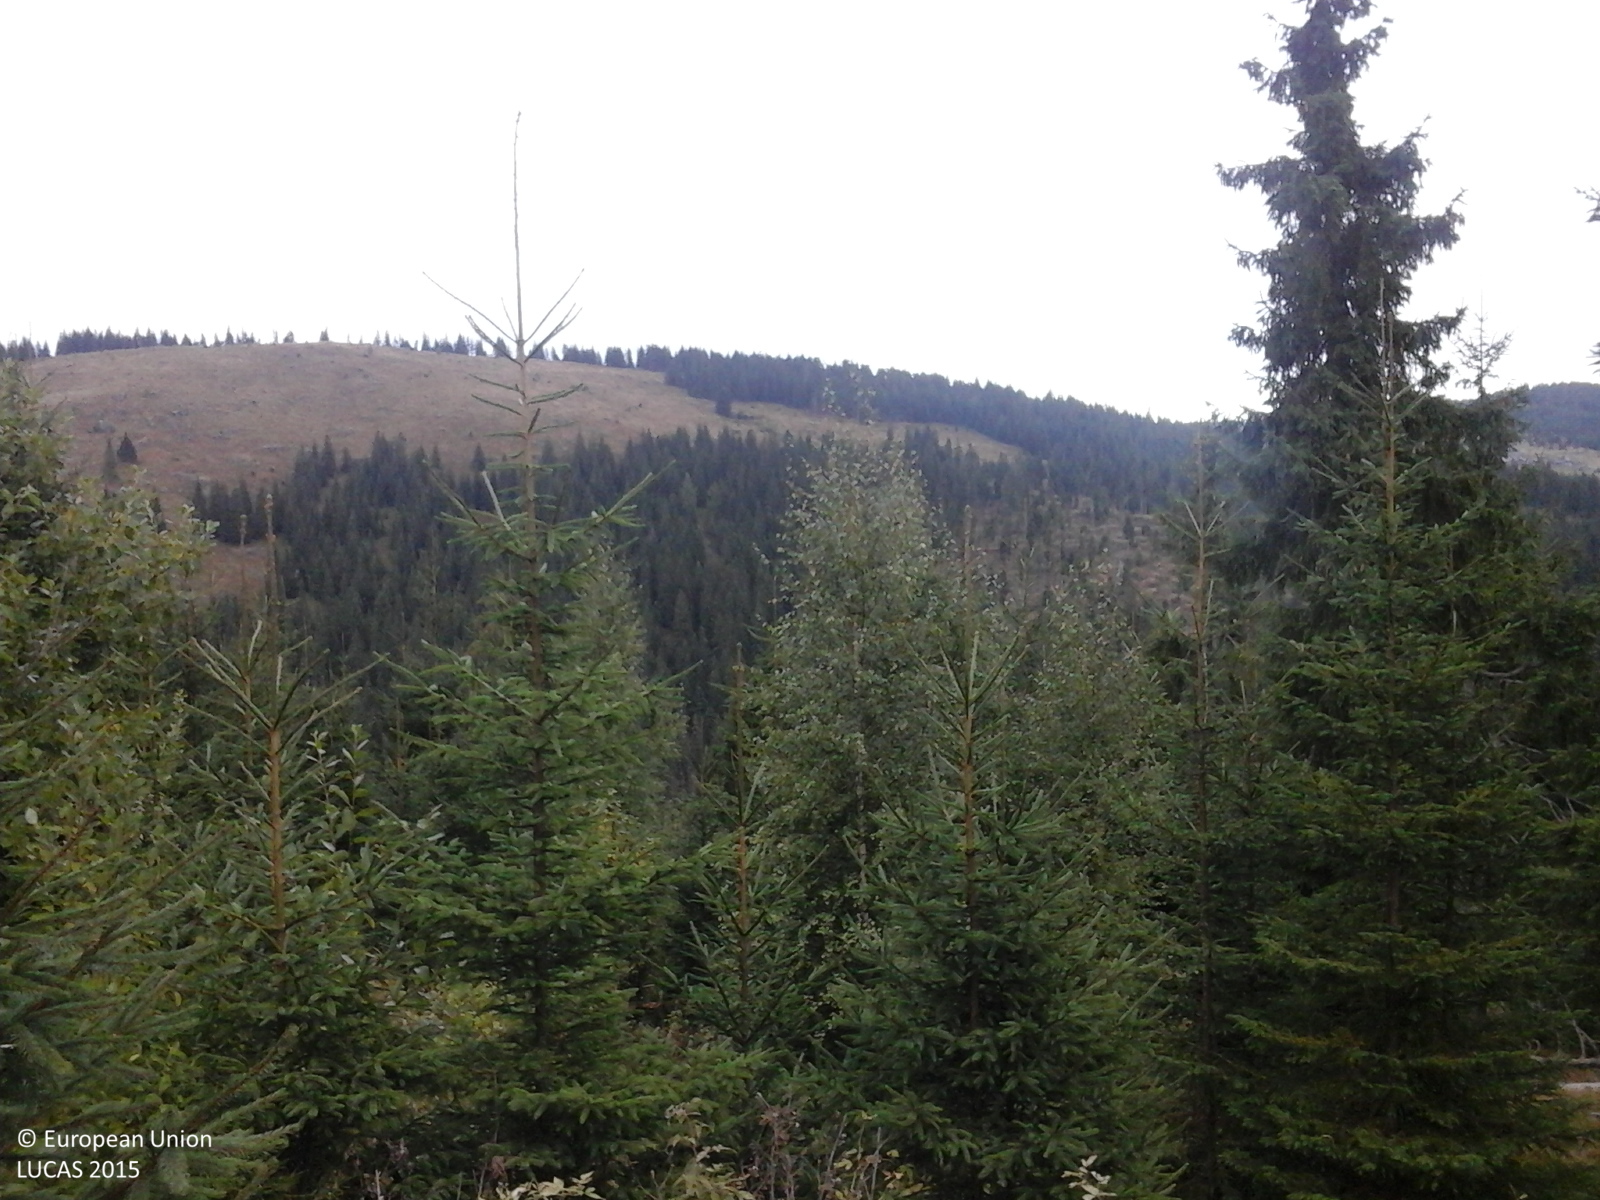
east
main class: Woodland
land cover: Spruce dominated mixed woodland
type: alpine coniferous forest
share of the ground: > 75 %
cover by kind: coniferous forest trees 70 %, broadleaved forest trees 30 %
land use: Forestry
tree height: > 5 m
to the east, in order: Spruce dominated mixed woodland; Tracks; Spruce dominated mixed woodland; Rivers and streams; Spruce dominated mixed woodland
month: October
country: RO
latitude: 46.5925
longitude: 23.1539
